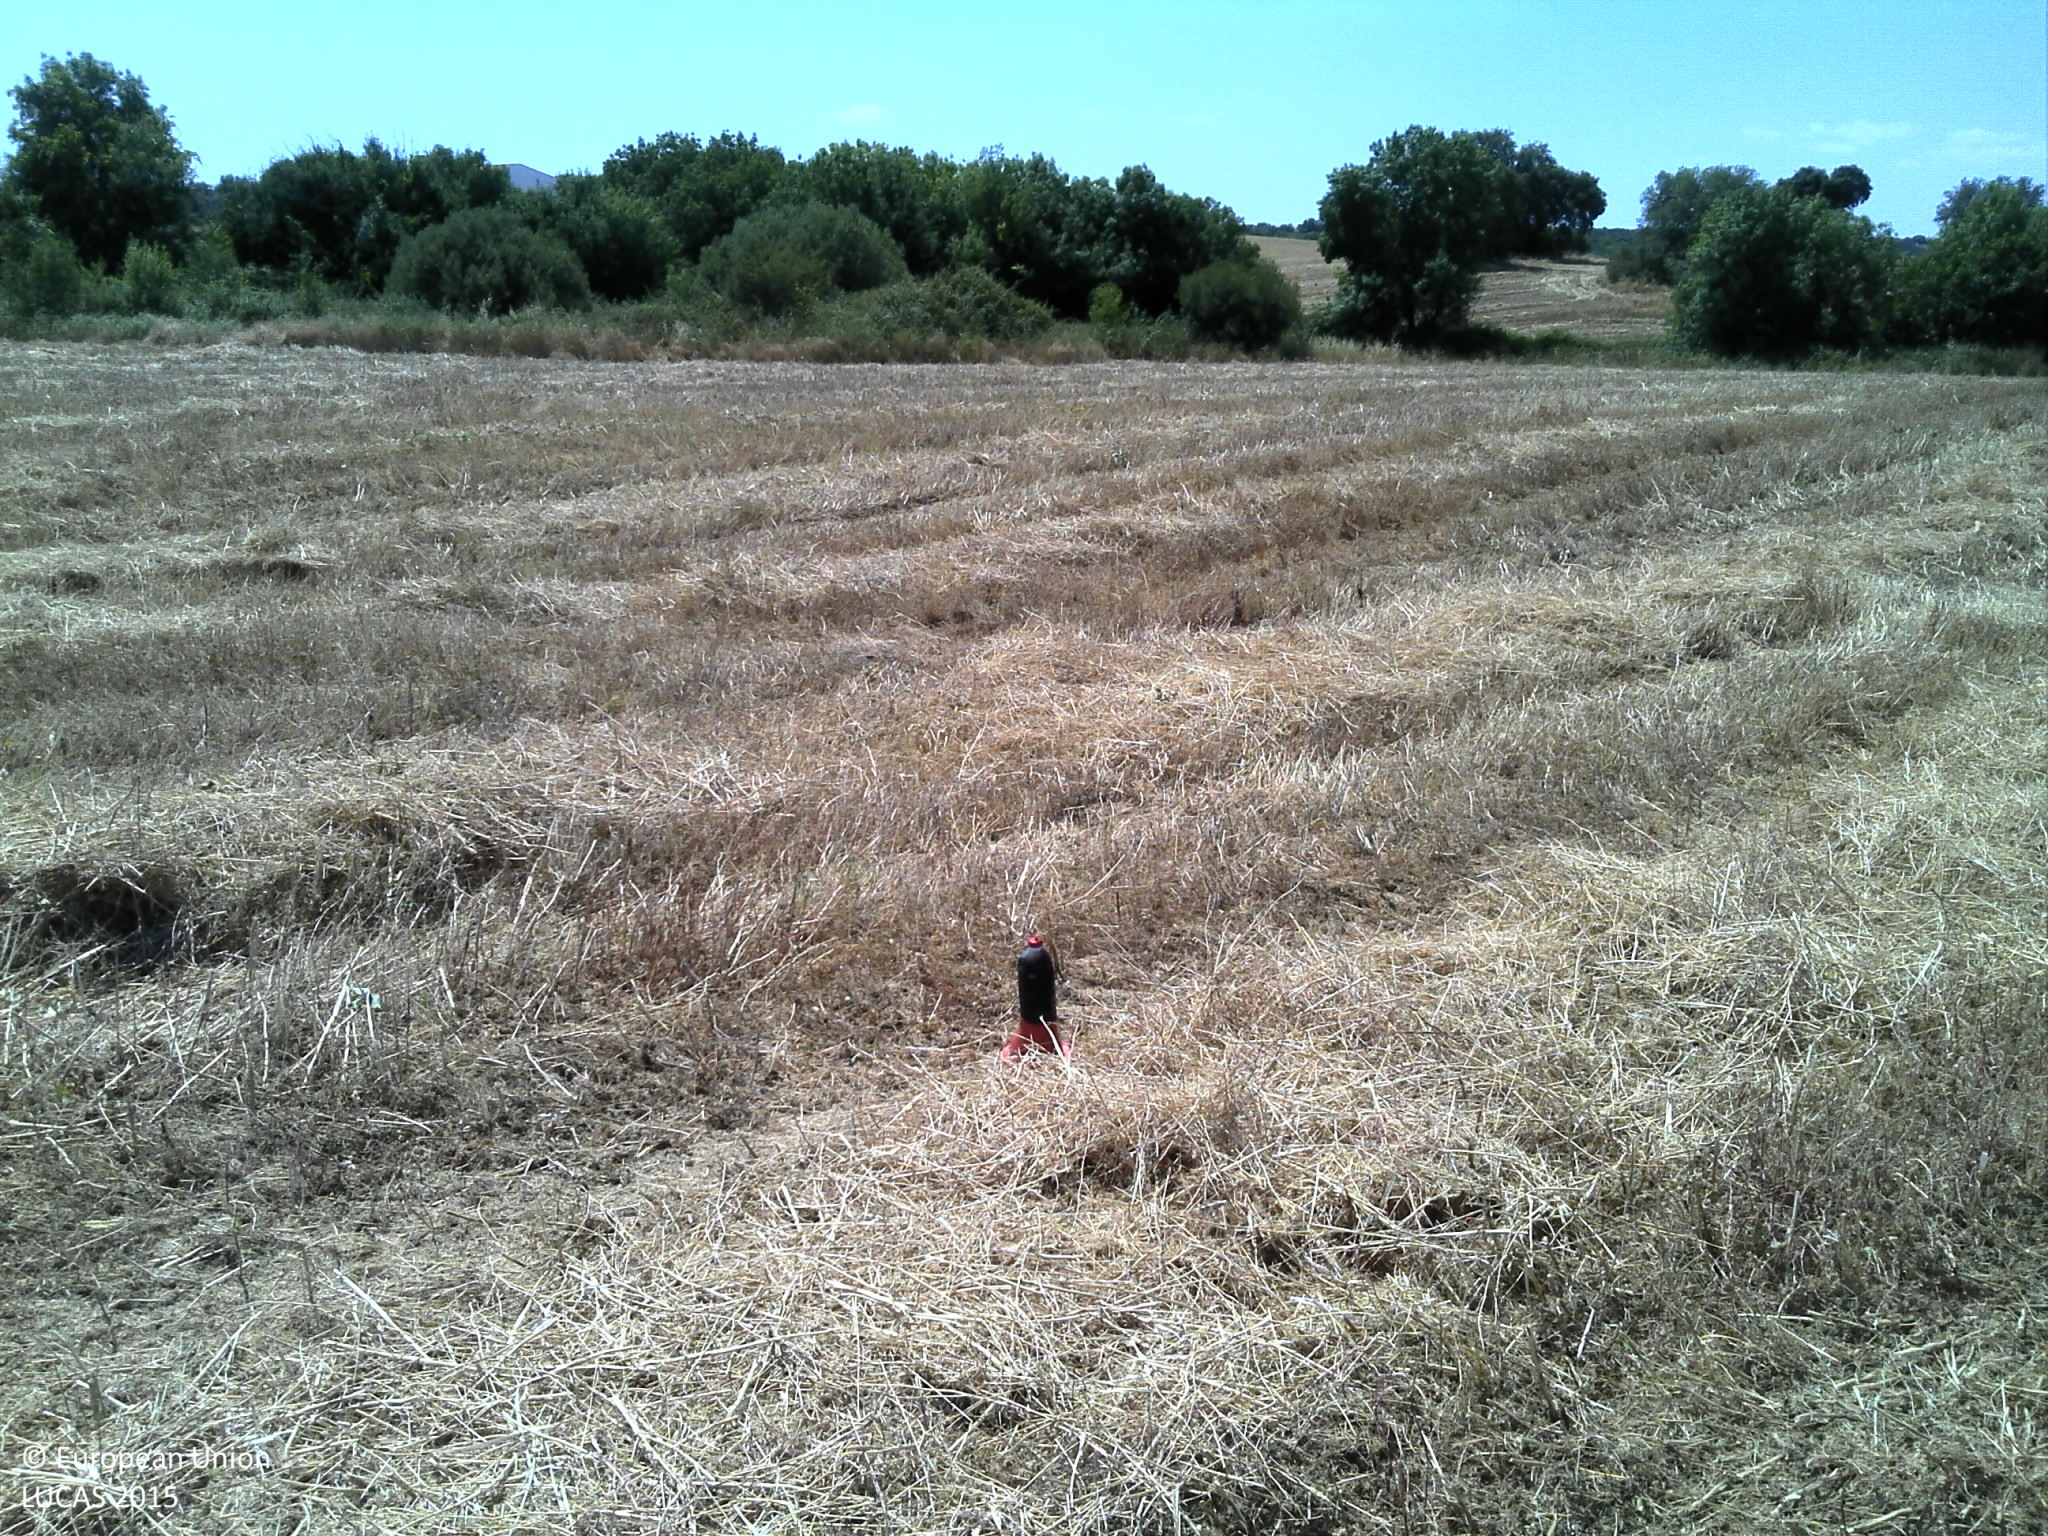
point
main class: Cropland
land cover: Other leguminous and mixtures for fodder
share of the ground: < 10 %
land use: Agriculture (excluding fallow land and kitchen gardens)
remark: Harvested field
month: June
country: PT
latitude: 38.2648
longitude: -7.9441
